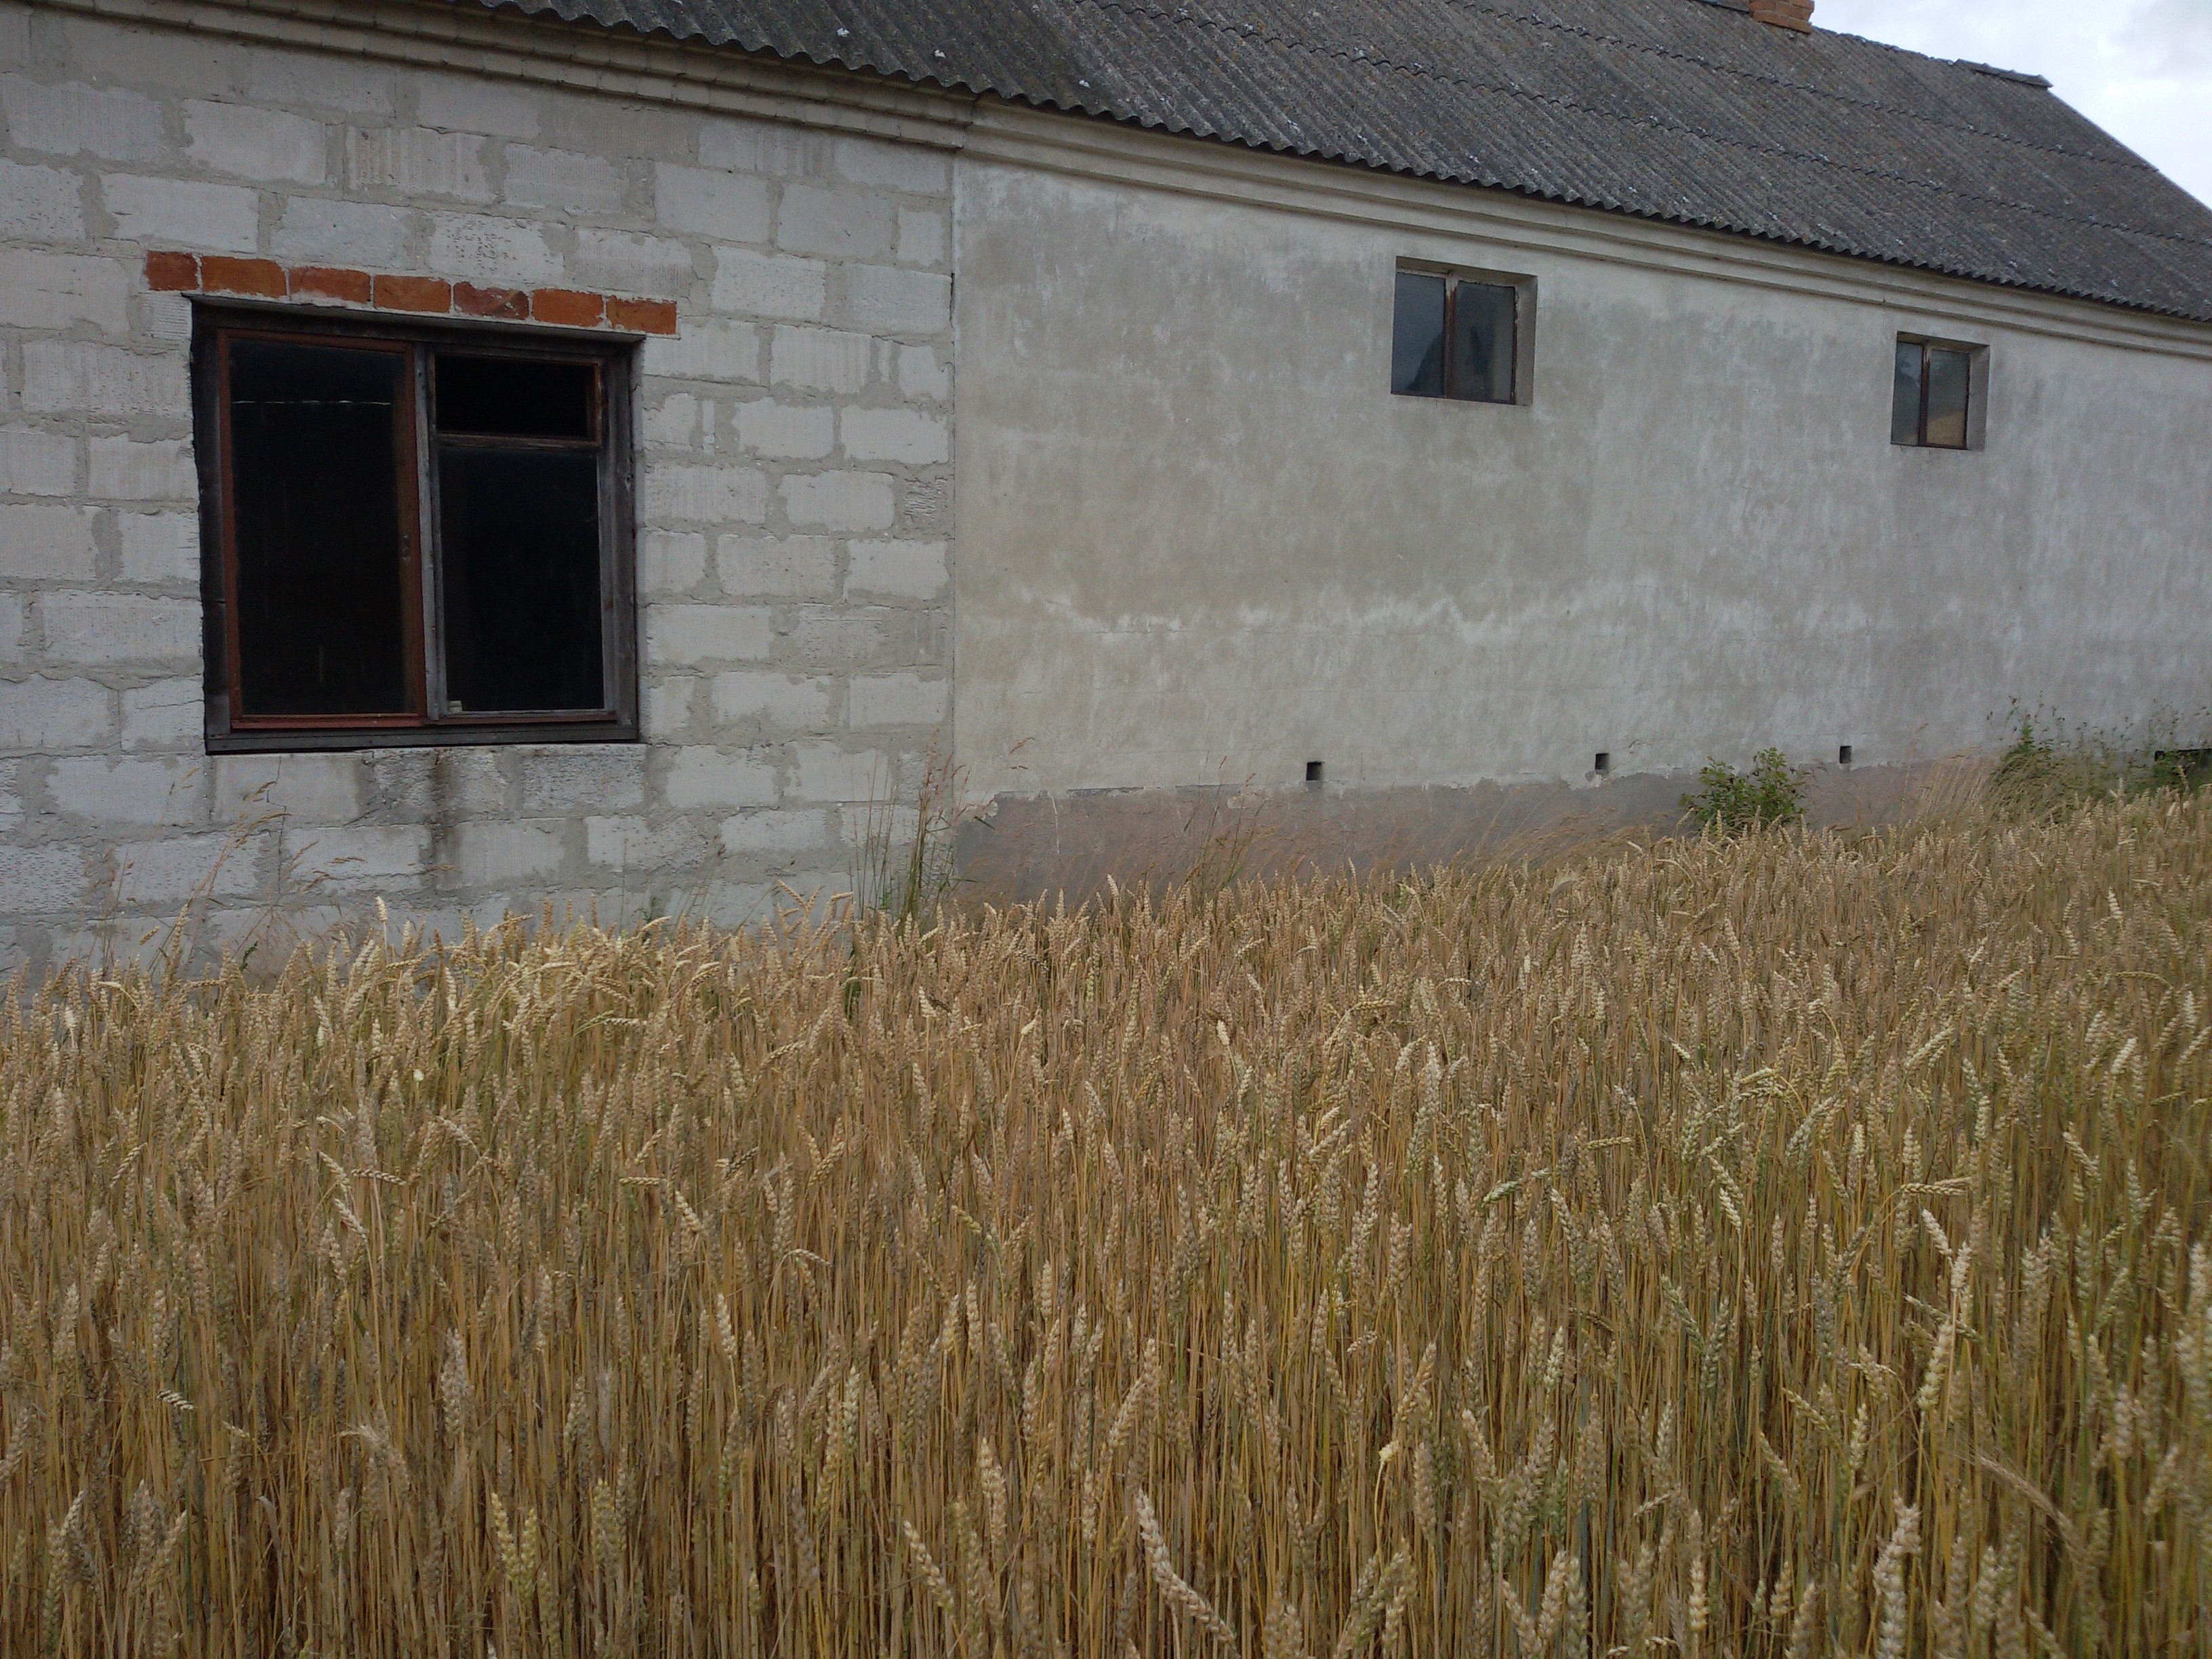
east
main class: Cropland
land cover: Common wheat
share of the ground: > 75 %
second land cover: Spontaneously vegetated surfaces
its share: 25 - 50 %
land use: Agriculture (excluding fallow land and kitchen gardens)
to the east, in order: Common wheat; Spontaneously vegetated surfaces; Artificial constructions in urban areas; Rye; Artificial constructions in urban areas; Oats; Grassland without tree/shrub cover
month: July
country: PL
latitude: 51.8351
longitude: 22.8876
